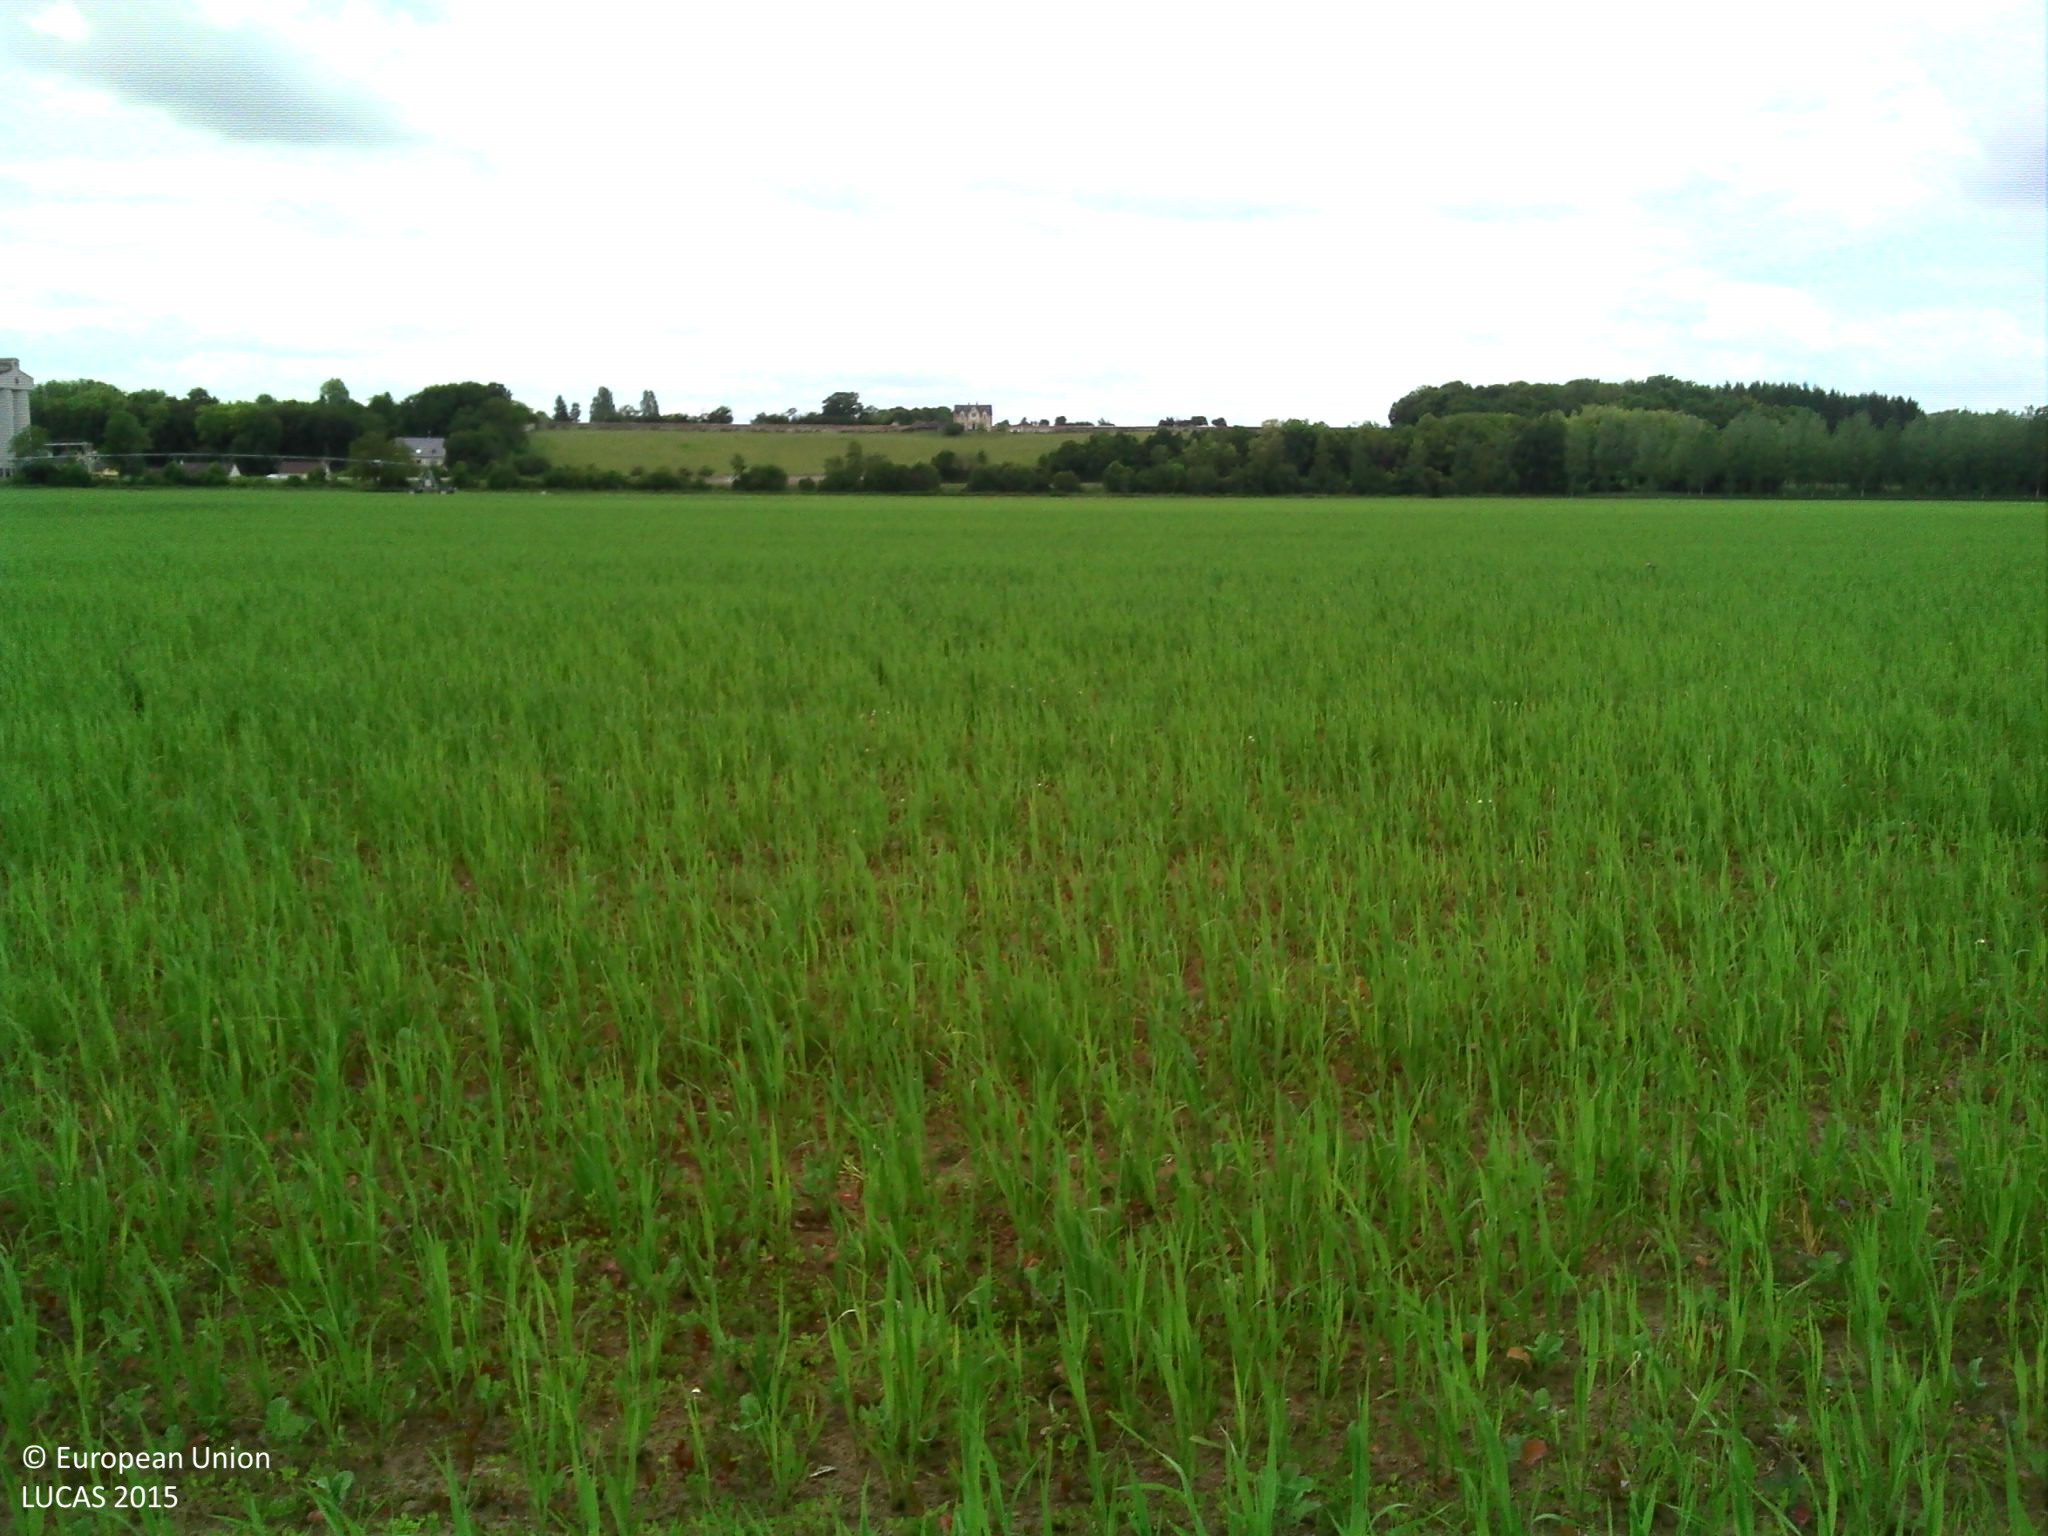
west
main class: Cropland
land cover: Other leguminous and mixtures for fodder
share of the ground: > 75 %
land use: Agriculture (excluding fallow land and kitchen gardens)
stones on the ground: < 10 %
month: May
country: FR
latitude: 47.4166
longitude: 2.9030
